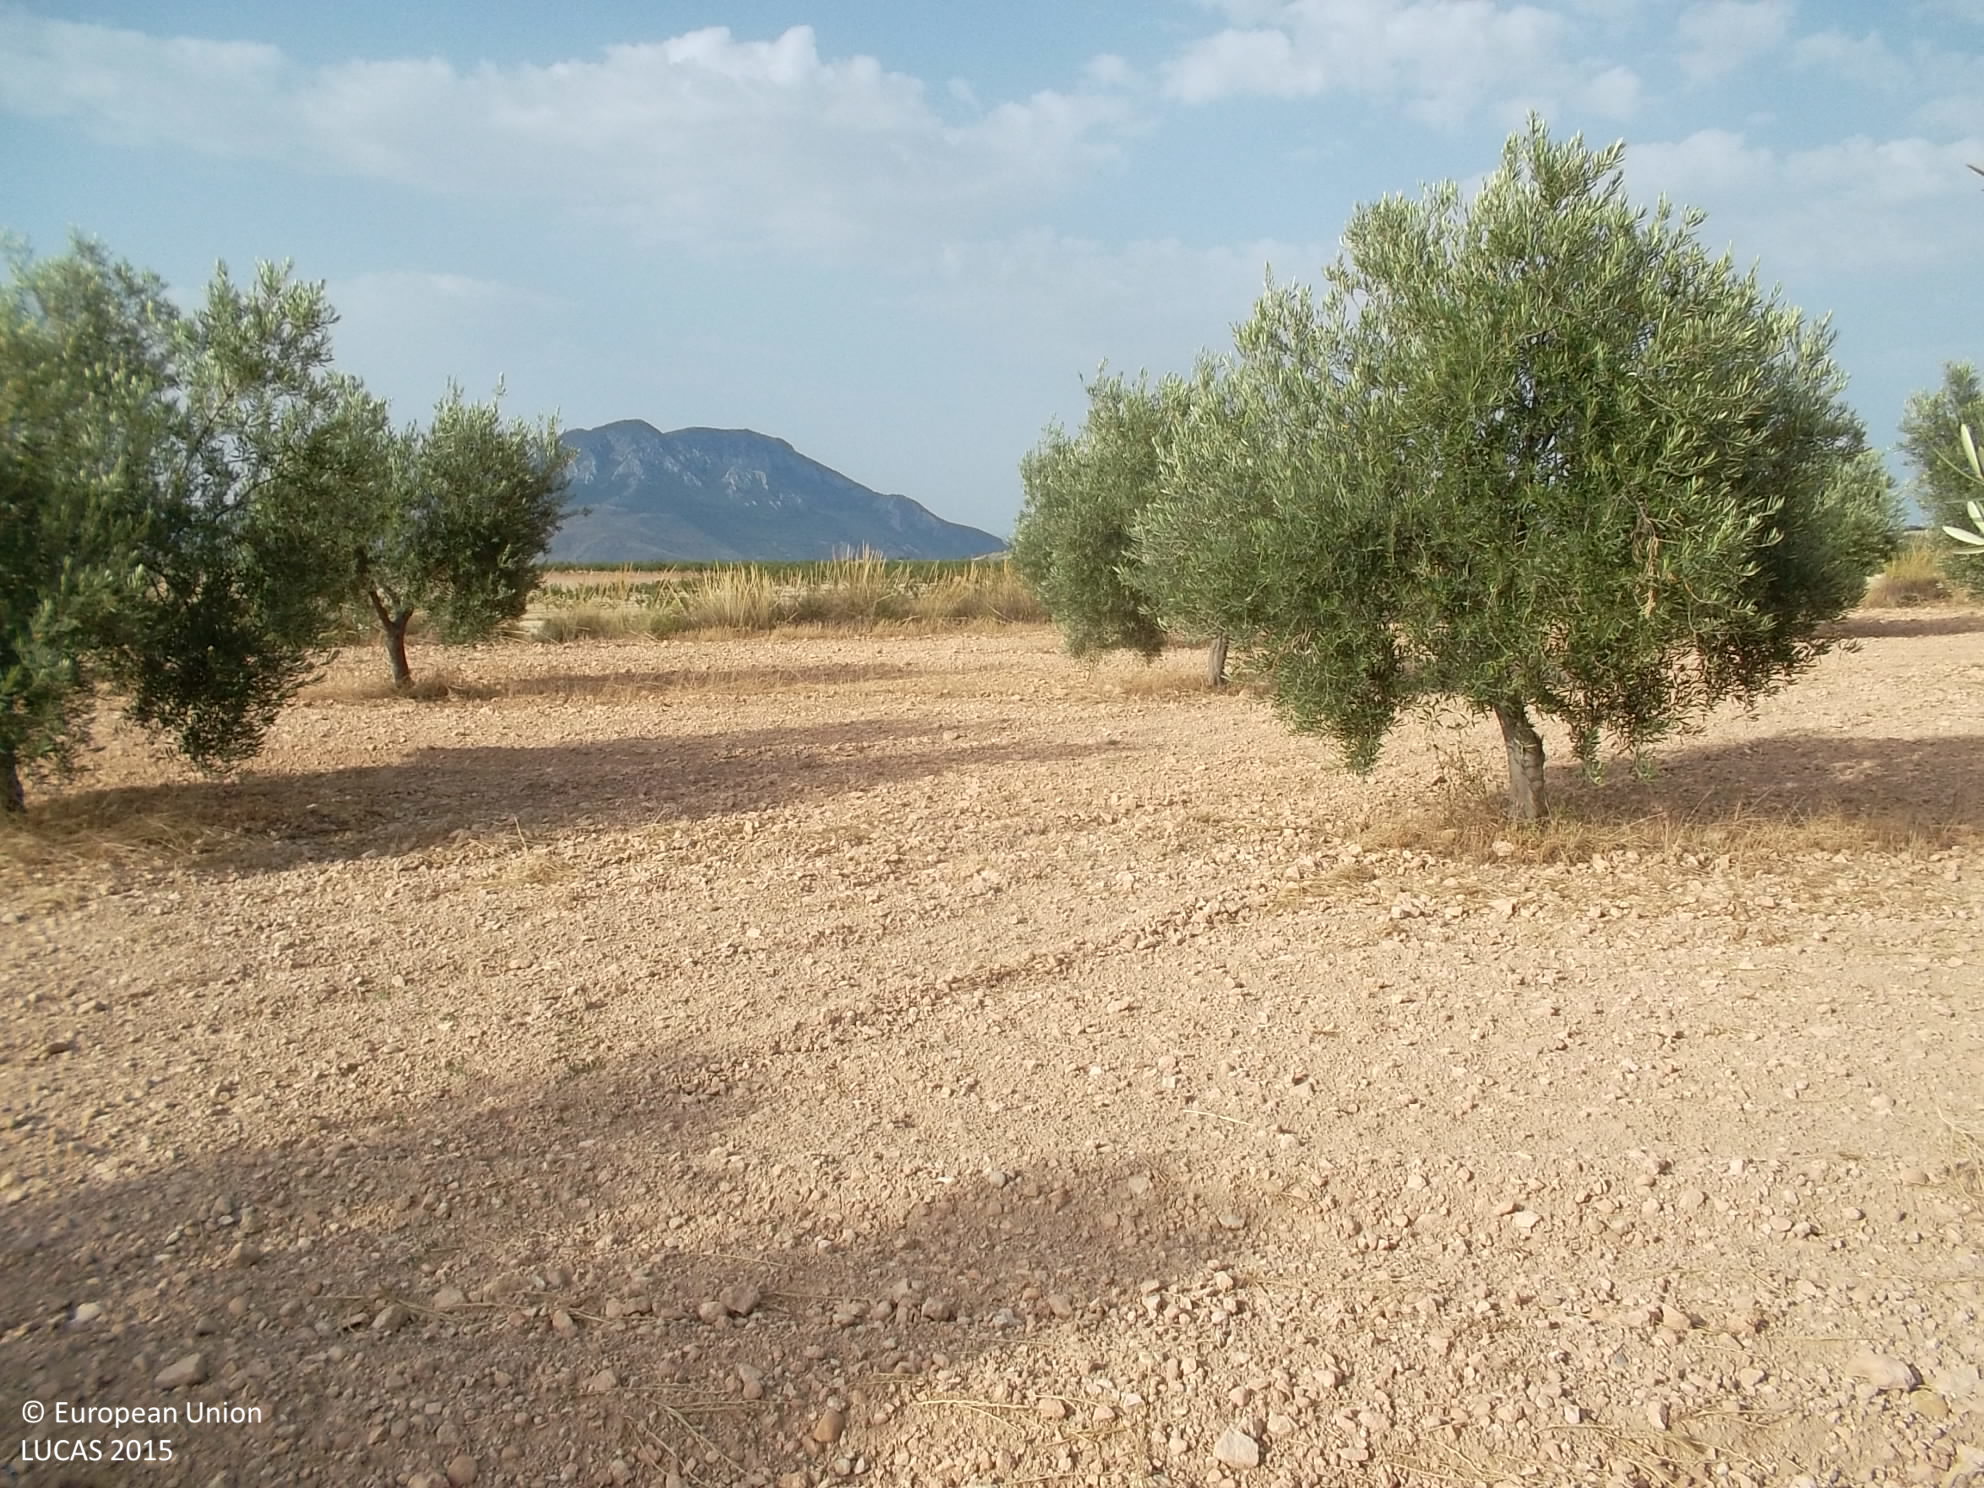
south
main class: Cropland
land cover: Olive groves
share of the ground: 25 - 50 %
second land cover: Other bare soil
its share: > 75 %
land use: Agriculture (excluding fallow land and kitchen gardens)
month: July
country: ES
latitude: 37.6507
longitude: -2.7860
